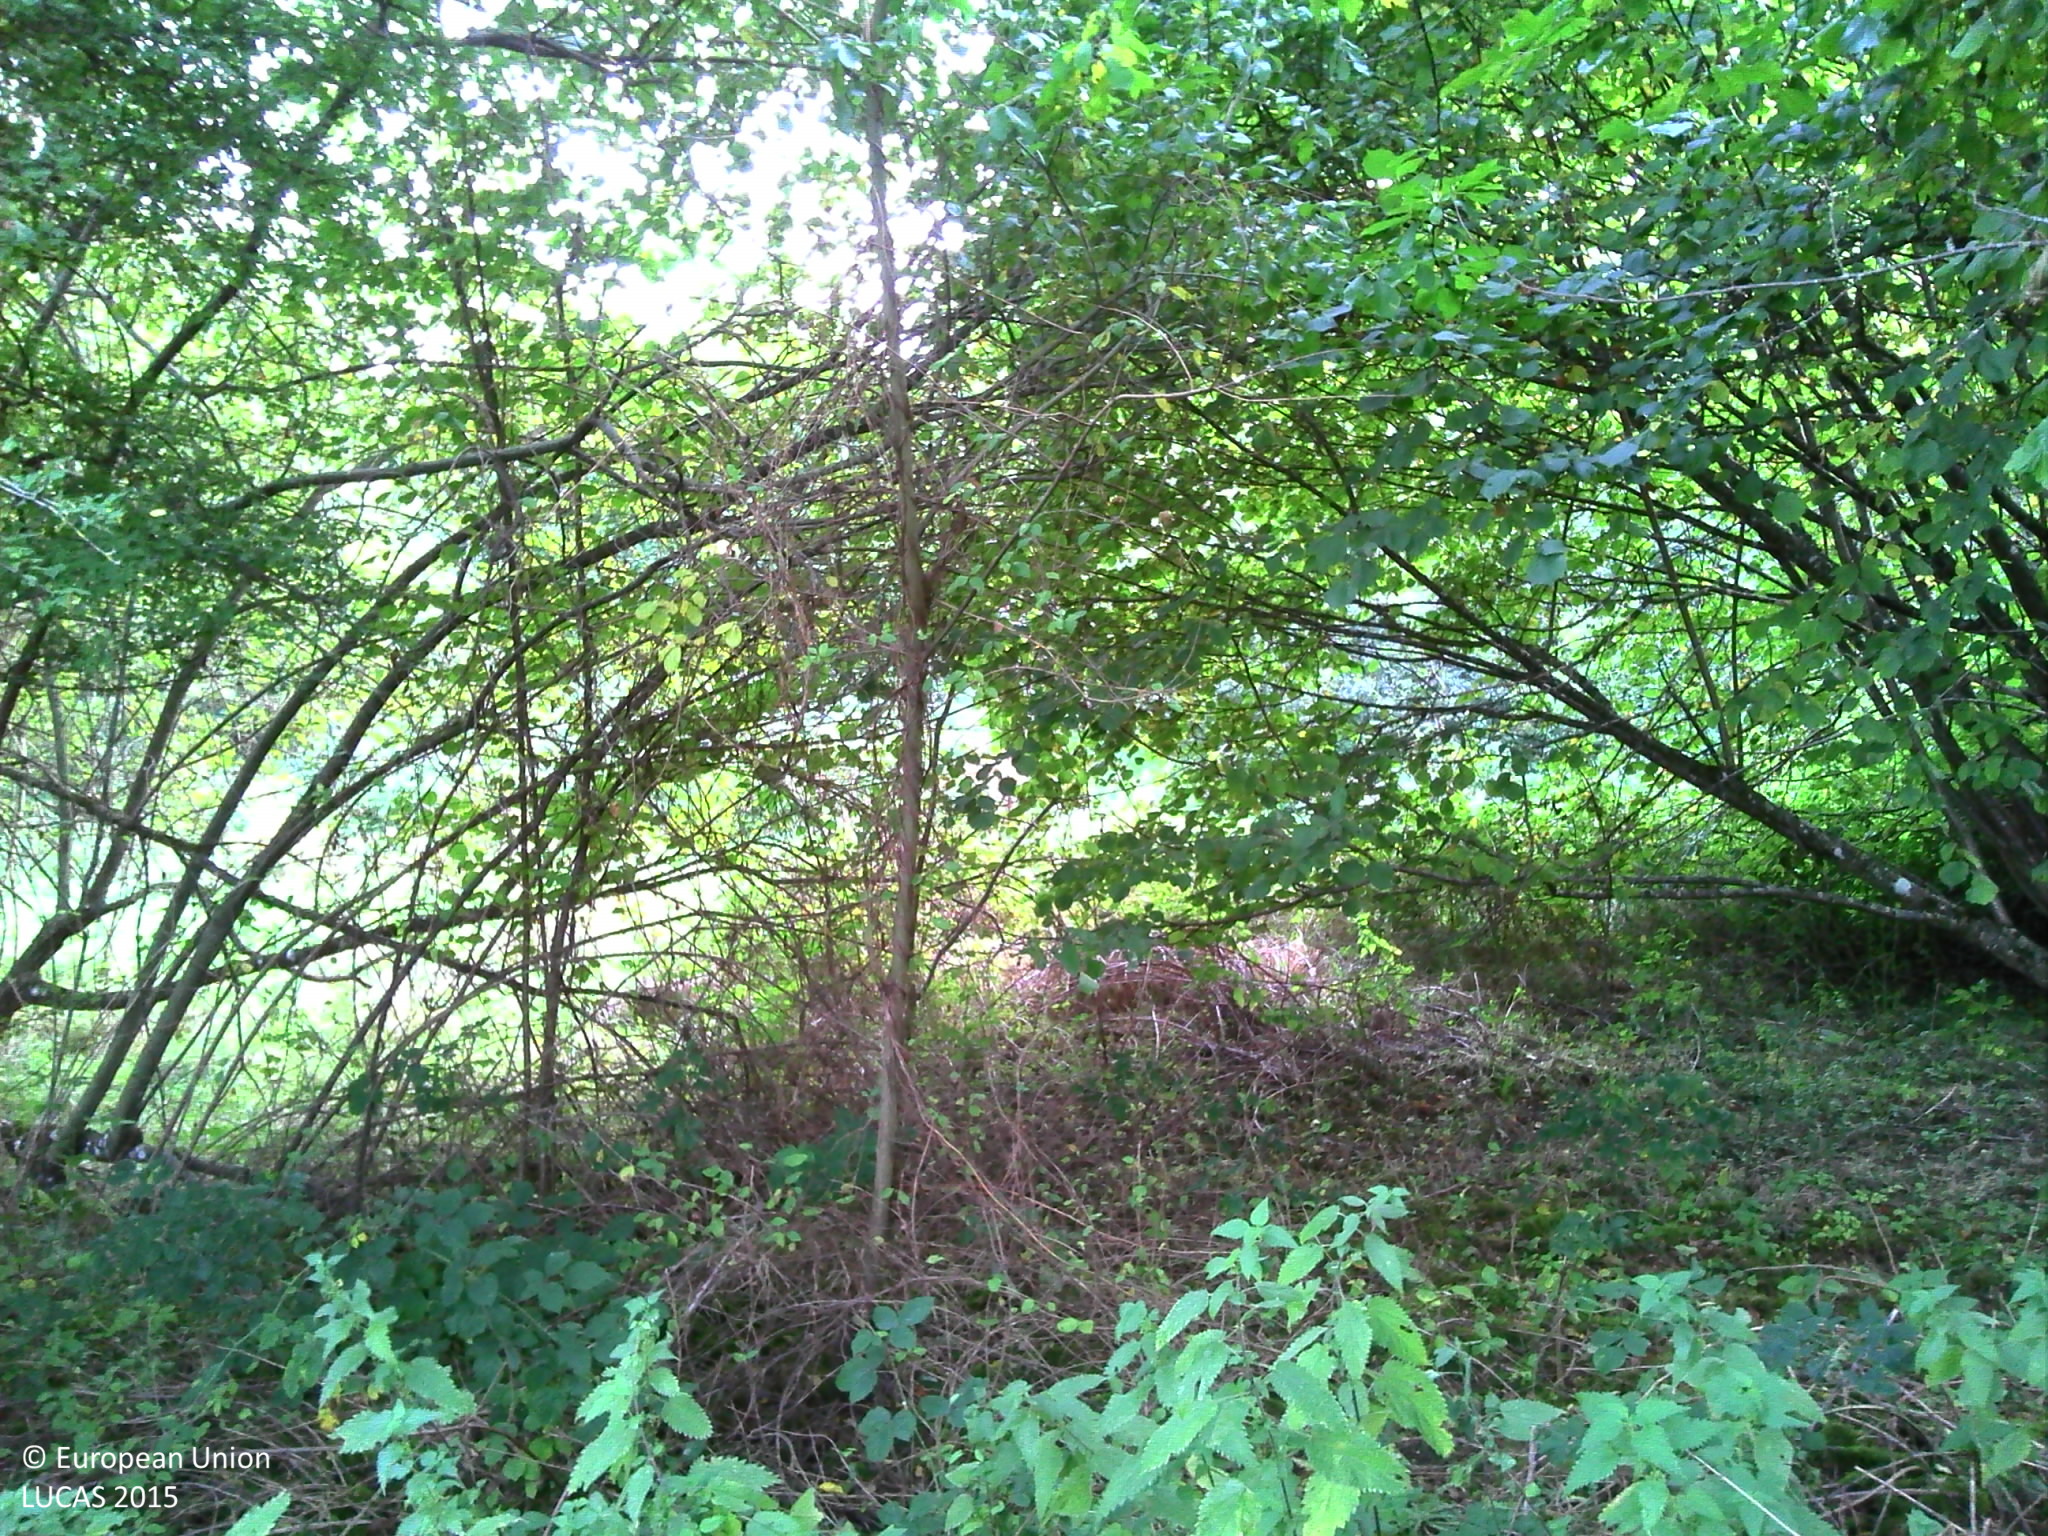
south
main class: Woodland
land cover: Broadleaved woodland
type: mesophytic deciduous forest
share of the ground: > 75 %
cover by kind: broadleaved forest trees 75 %, herbaceous plants 25 %
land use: Forestry
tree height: > 5 m
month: September
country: FR
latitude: 46.1633
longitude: 2.8099
